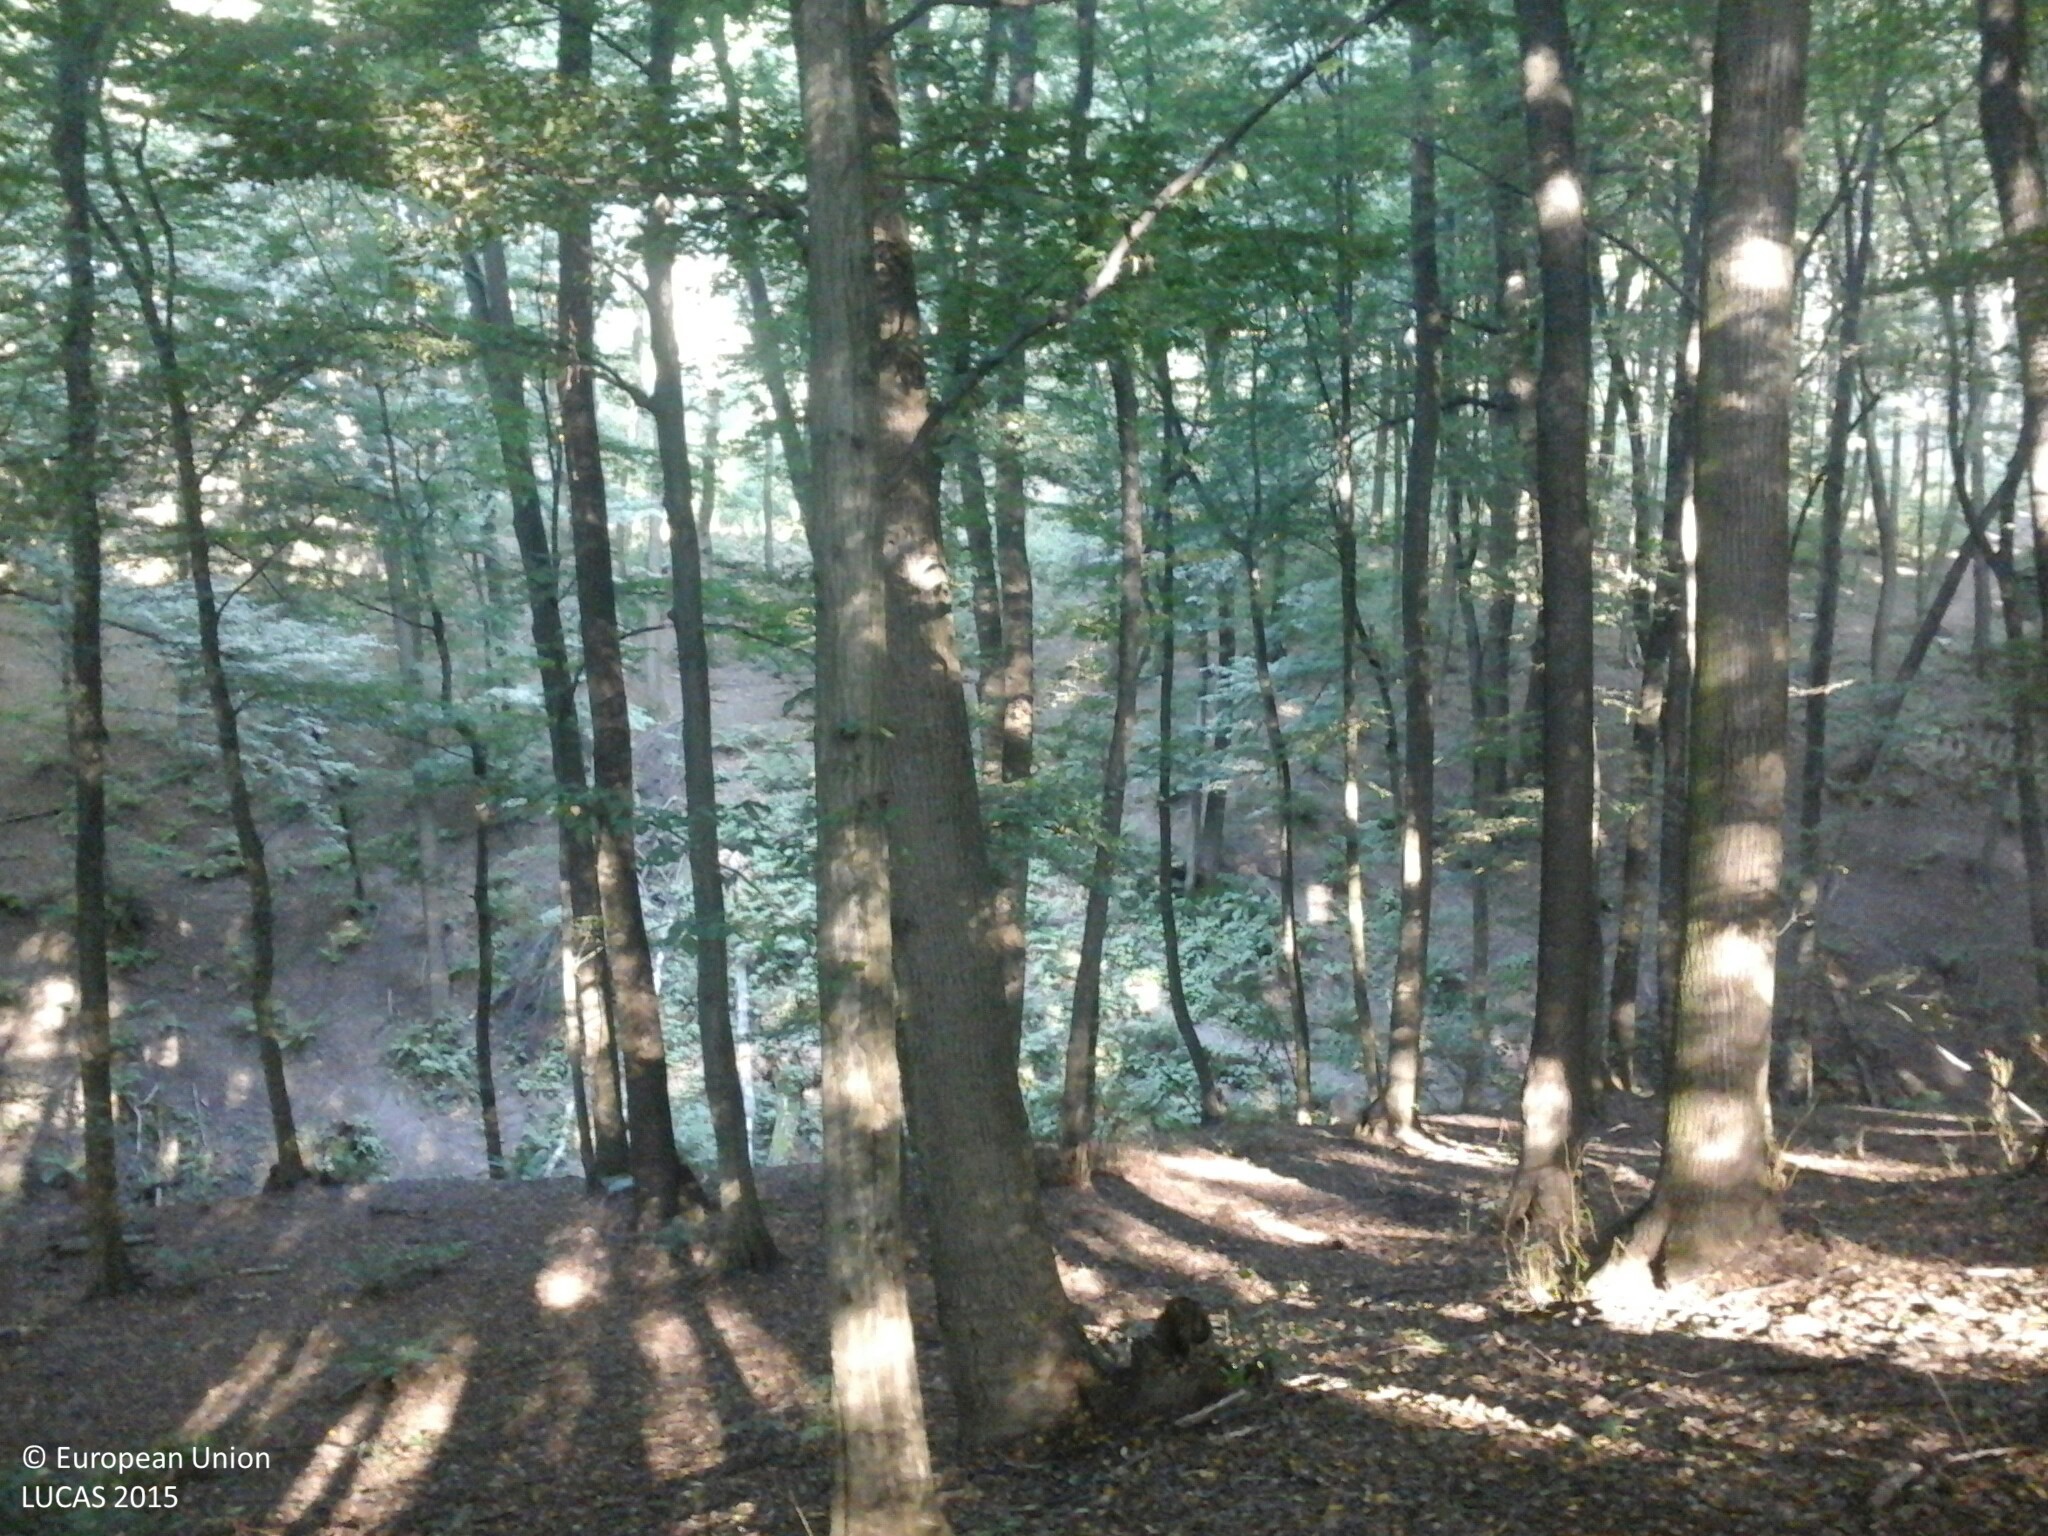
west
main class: Woodland
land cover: Broadleaved woodland
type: mesophytic deciduous forest
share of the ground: > 75 %
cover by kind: broadleaved forest trees 95 %, herbaceous plants 5 %
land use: Forestry
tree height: > 5 m
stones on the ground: < 10 %
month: August
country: HU
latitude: 47.5032
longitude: 18.4170
